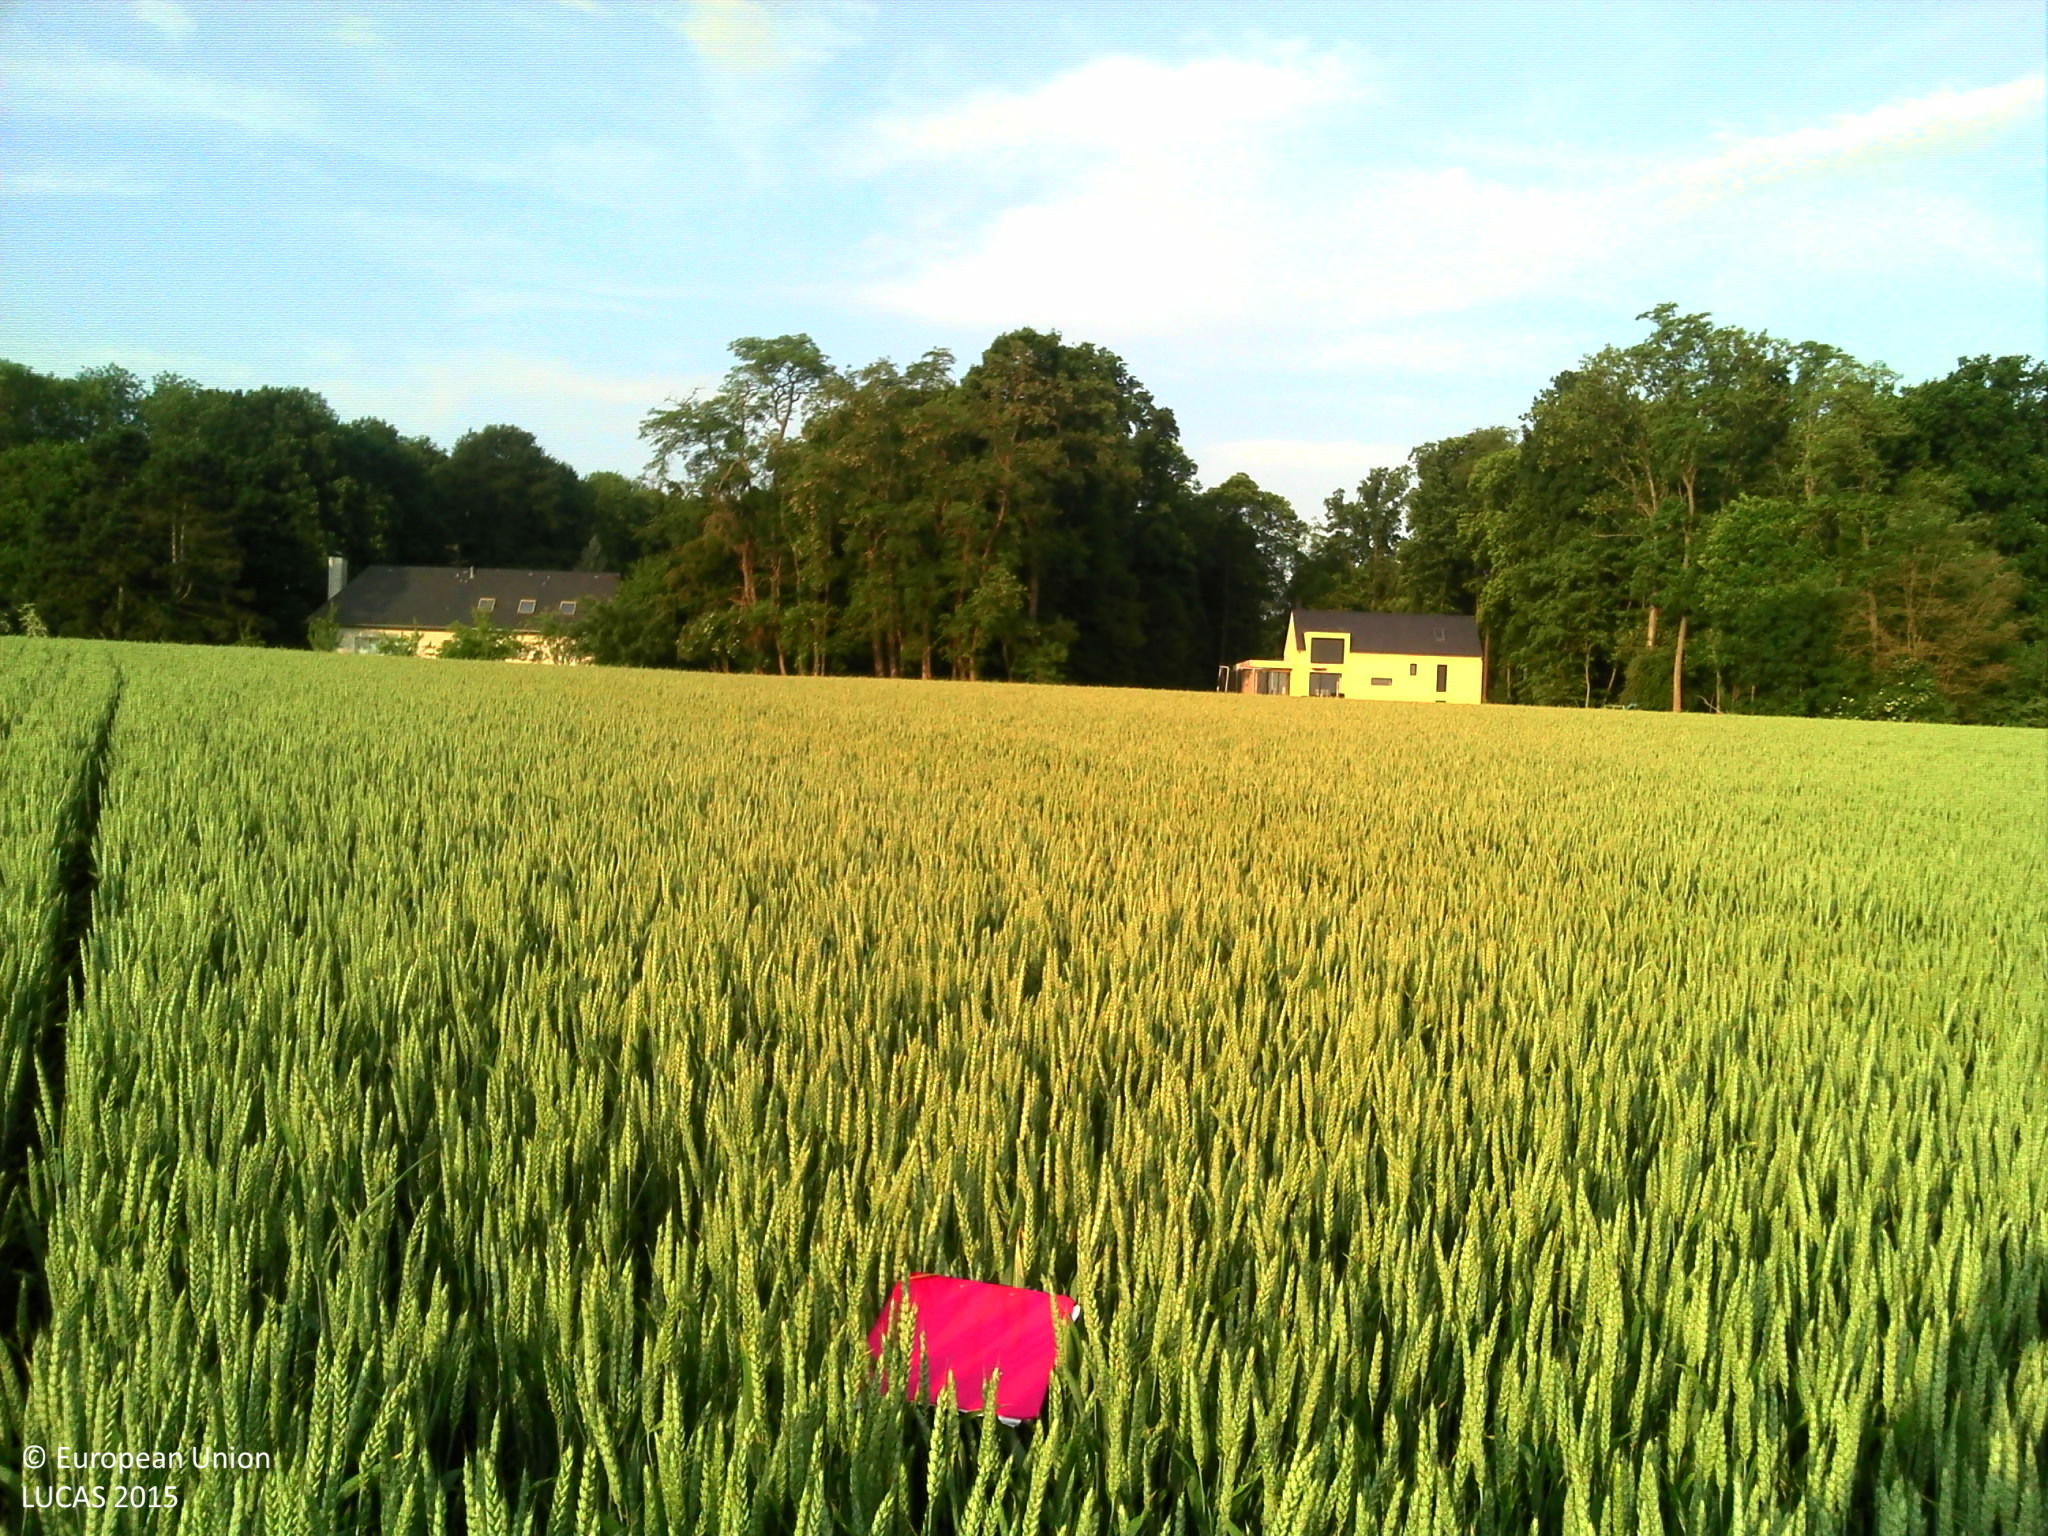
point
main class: Cropland
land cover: Common wheat
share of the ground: > 75 %
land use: Agriculture (excluding fallow land and kitchen gardens)
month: June
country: FR
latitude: 49.4886
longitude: 2.8250
